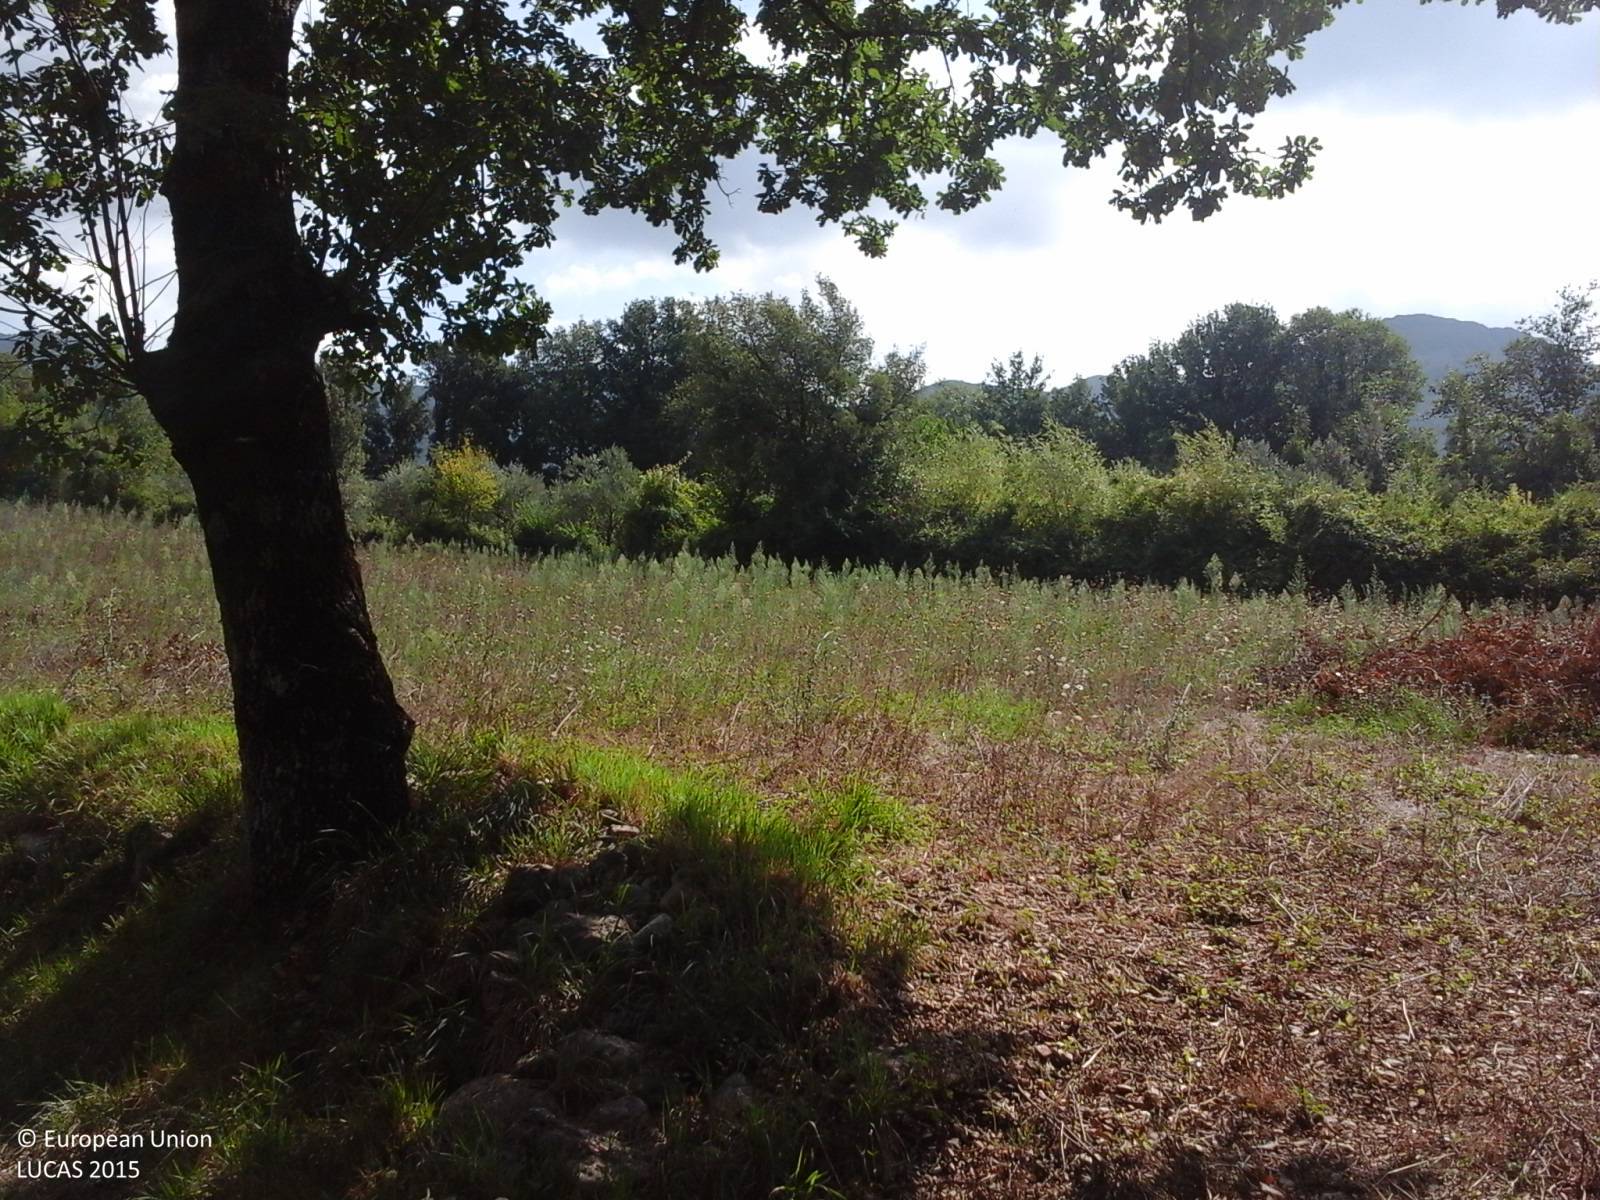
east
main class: Grassland
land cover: Grassland without tree/shrub cover
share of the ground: > 75 %
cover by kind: herbaceous plants 100 %
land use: Agriculture (excluding fallow land and kitchen gardens)
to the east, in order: Grassland without tree/shrub cover; Olive groves; Broadleaved woodland; Olive groves; Tracks; Olive groves; Broadleaved woodland; Grassland without tree/shrub cover; Broadleaved woodland
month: August
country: IT
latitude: 41.5378
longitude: 13.1641
